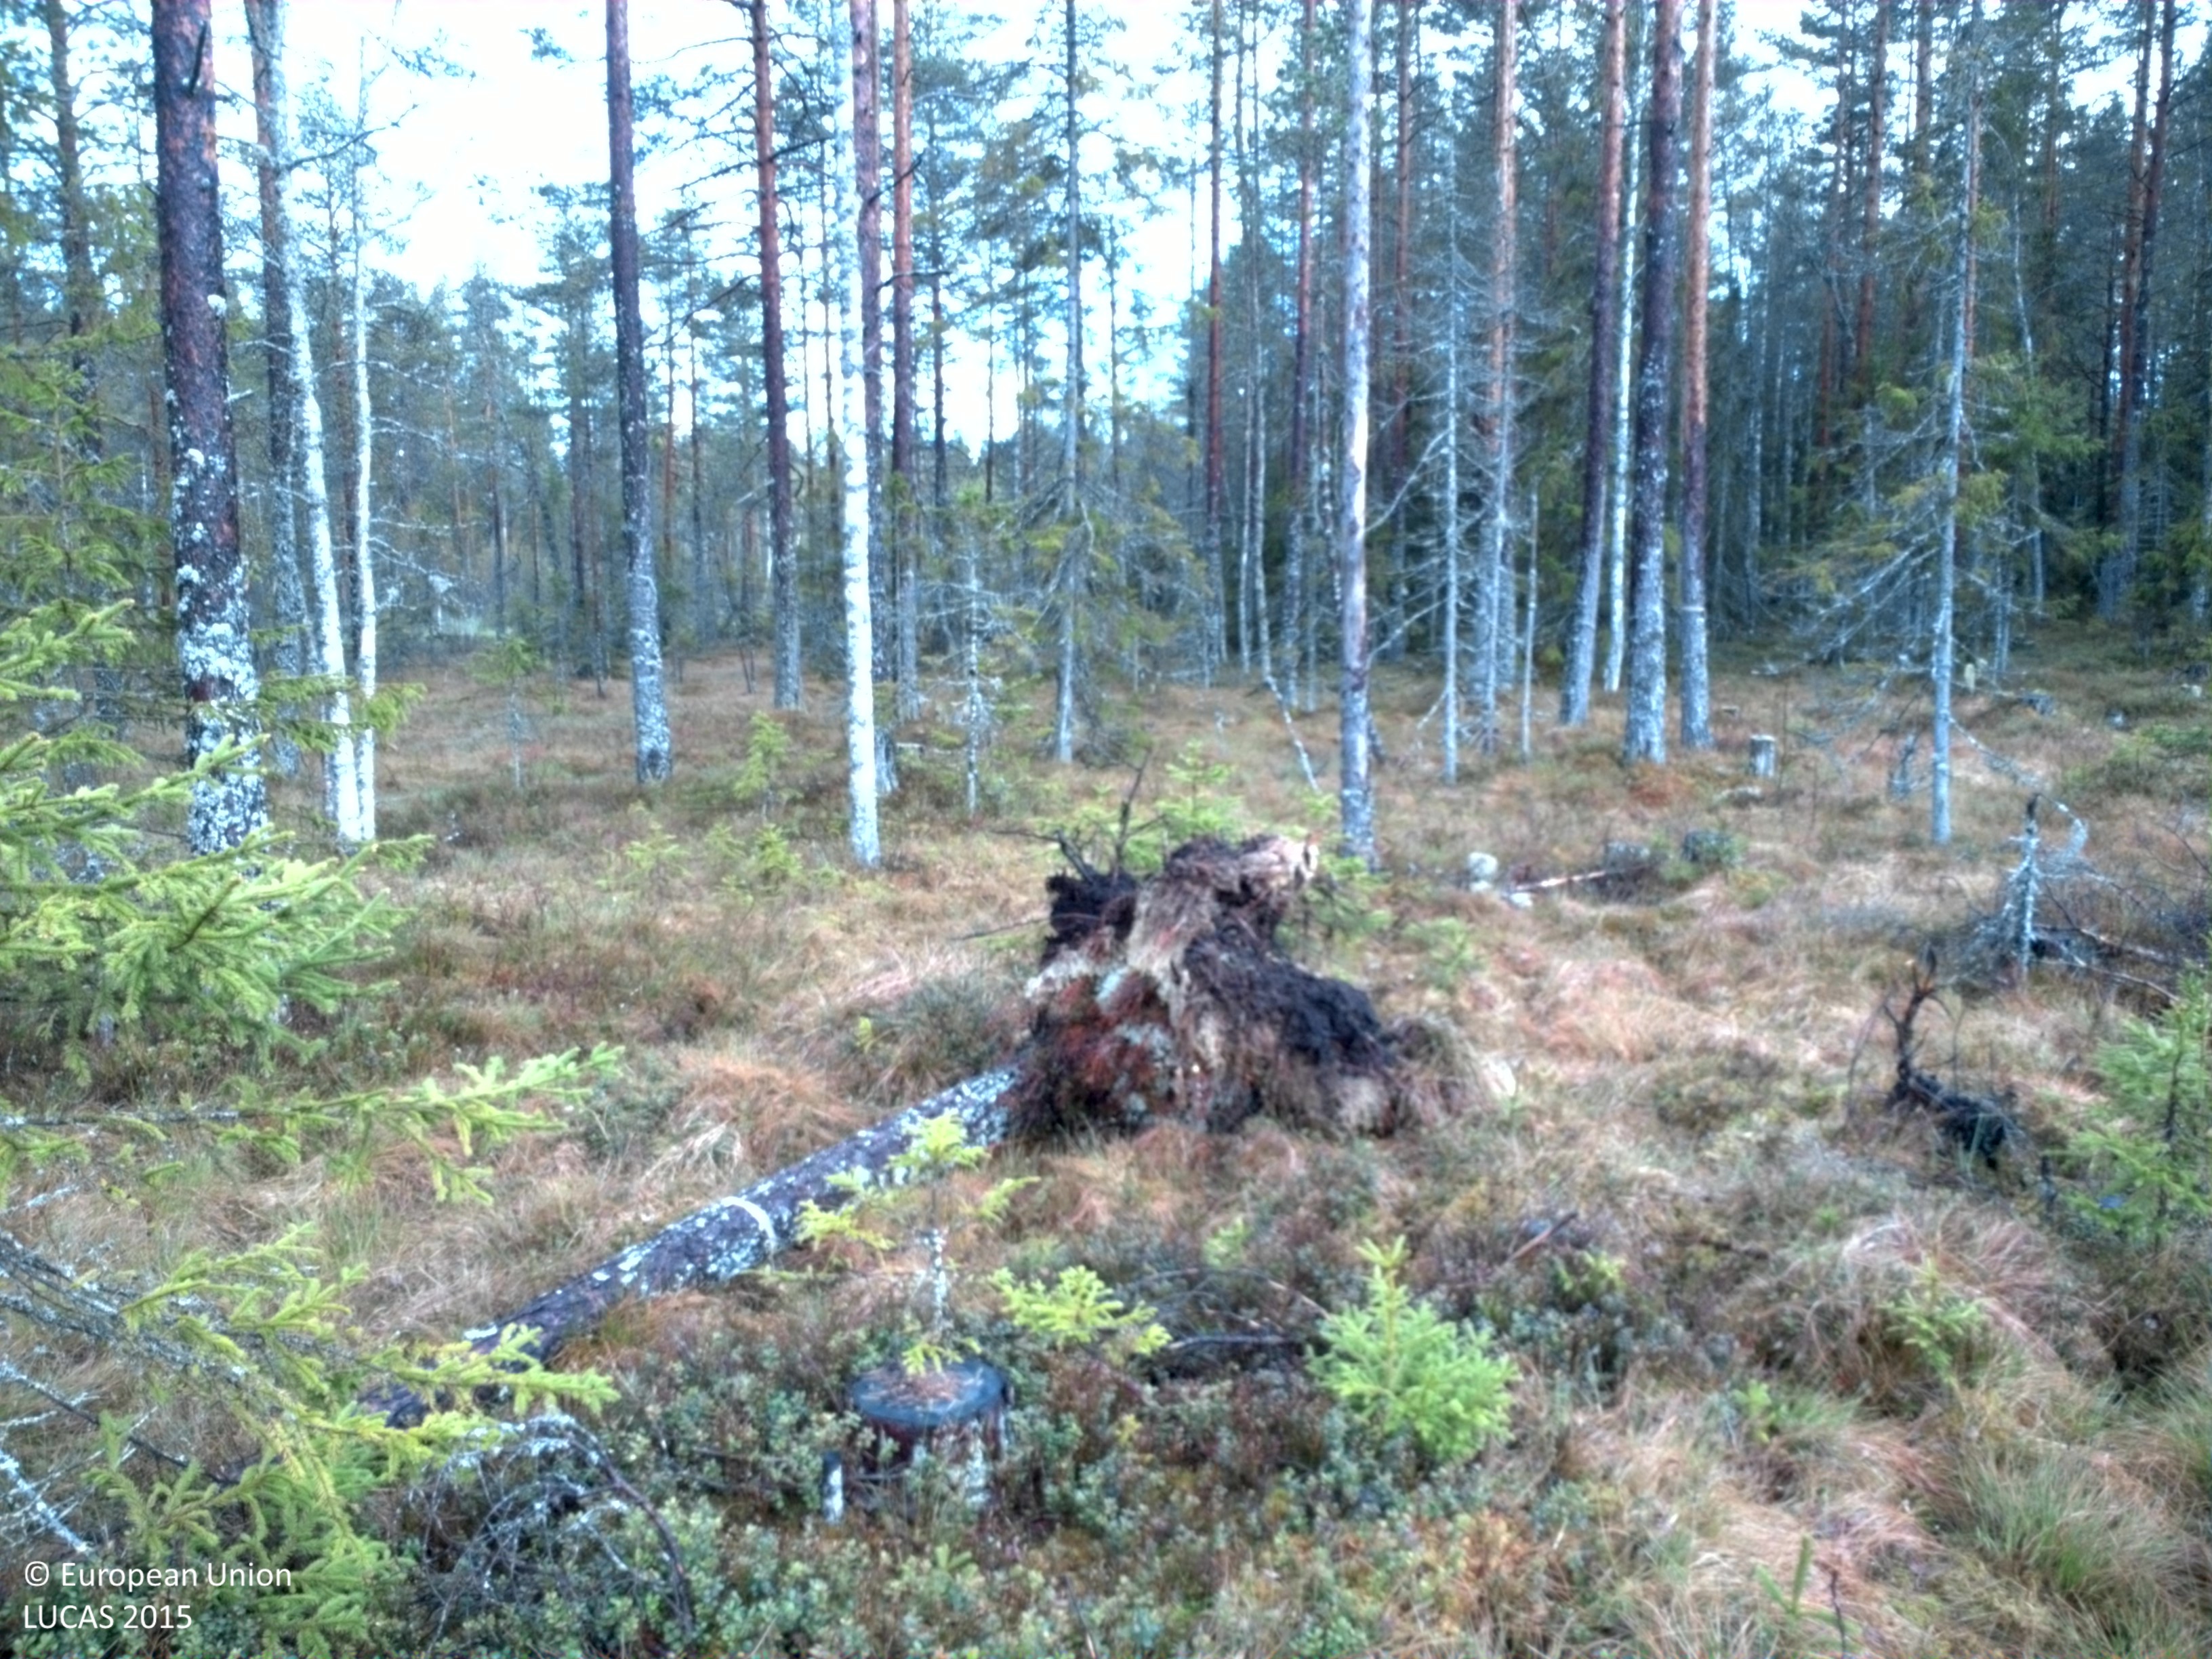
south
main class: Woodland
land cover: Spruce dominated mixed woodland
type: boreal forest
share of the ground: > 75 %
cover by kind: coniferous forest trees 55 %, broadleaved forest trees 25 %, herbaceous plants 10 %, shrubs 5 %, lichens and mosses 5 %
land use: Forestry
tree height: > 5 m
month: May
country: SE
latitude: 61.1444
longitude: 14.8339
